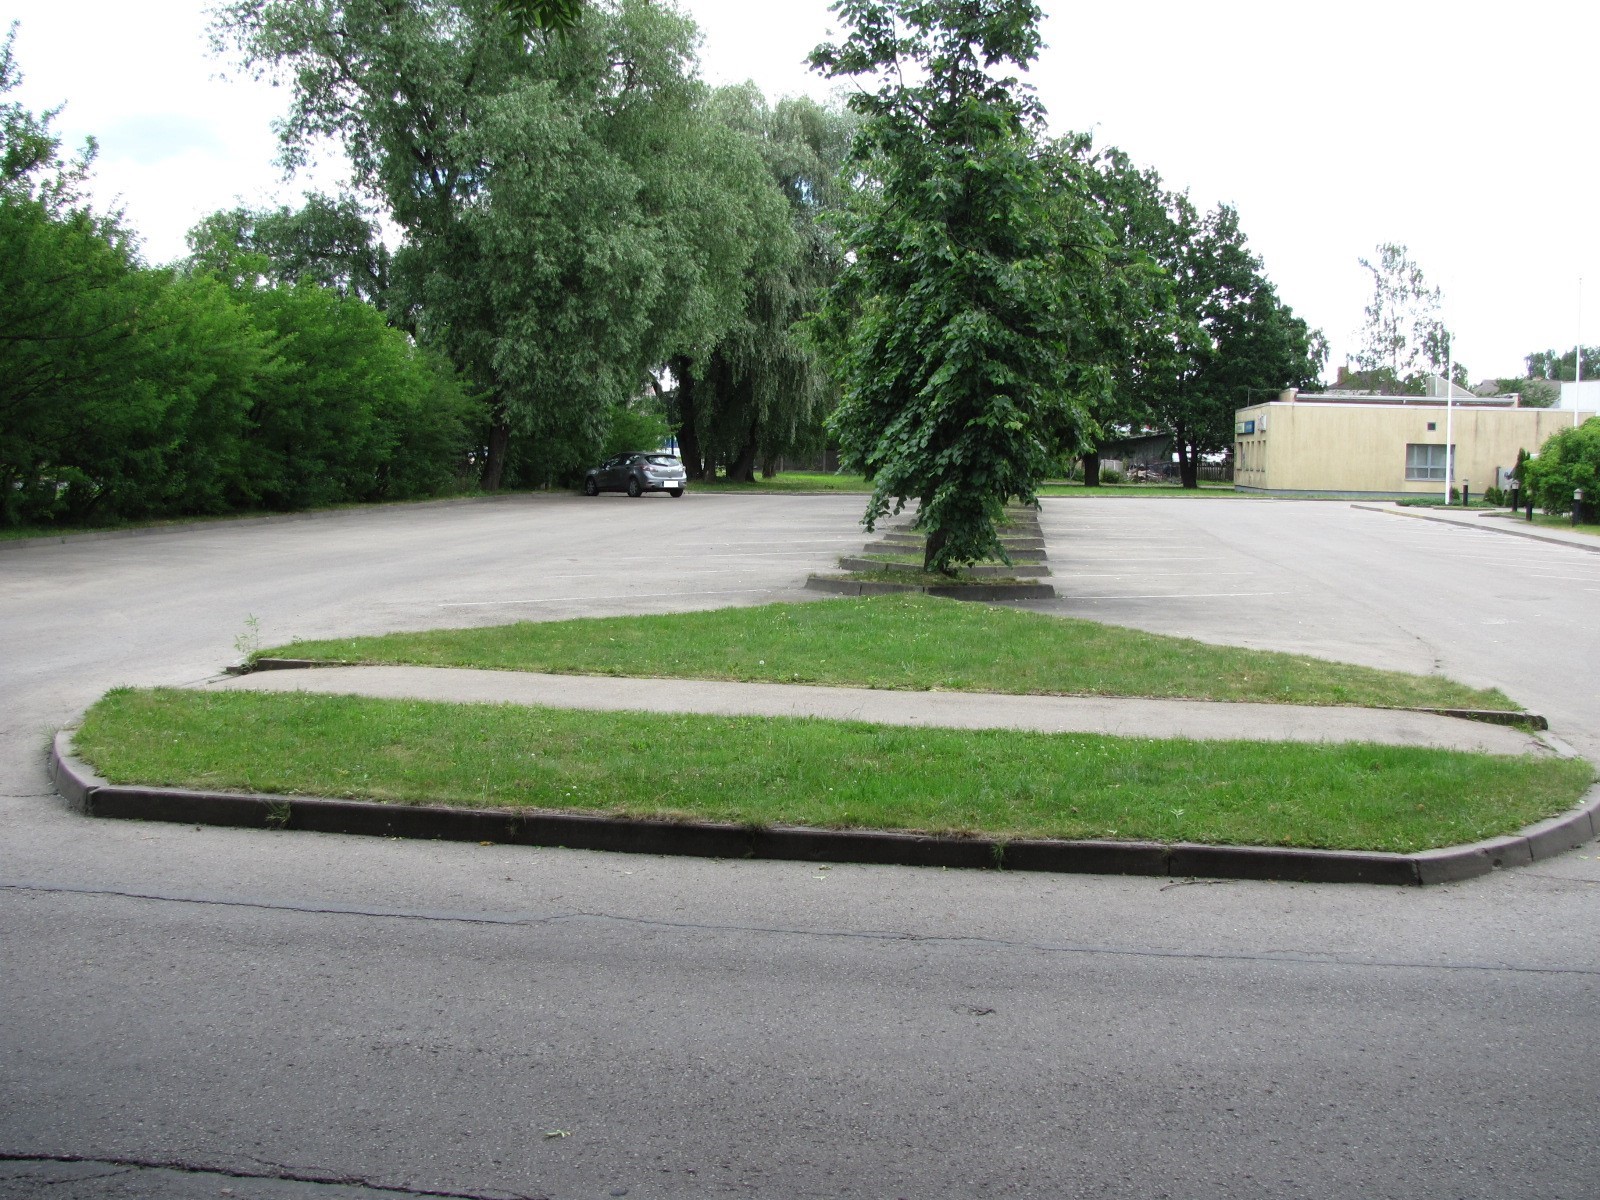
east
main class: Woodland
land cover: Broadleaved woodland
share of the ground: > 75 %
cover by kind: broadleaved forest trees 100 %
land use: Residential
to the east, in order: Broadleaved woodland; Artificial constructions in urban areas
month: June
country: LV
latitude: 56.9501
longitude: 24.1764
